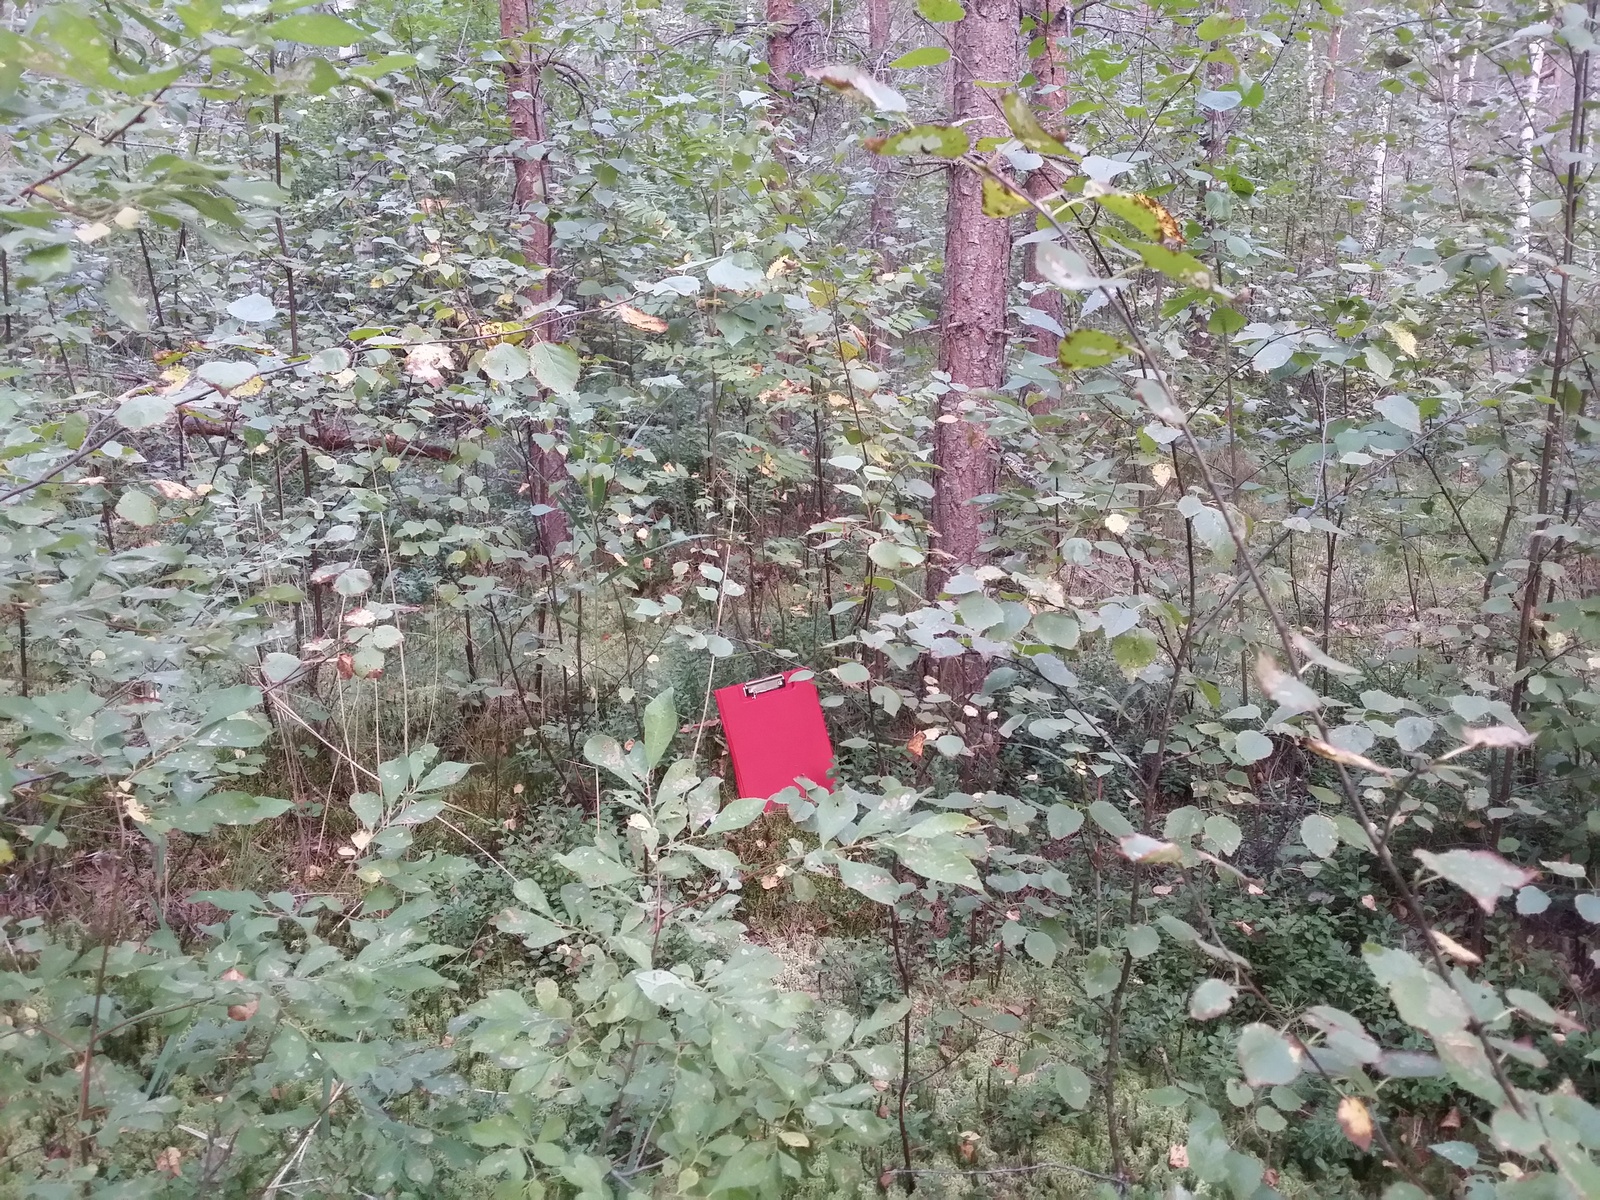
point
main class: Woodland
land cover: Pine dominated mixed woodland
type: hemiboreal forest and nemoral coniferous forest and mixed broadleaved-coniferous forest
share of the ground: > 75 %
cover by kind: coniferous forest trees 35 %, broadleaved forest trees 30 %, herbaceous plants 20 %, shrubs 10 %, lichens and mosses 5 %
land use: Forestry
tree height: > 5 m
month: August
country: LV
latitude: 56.9822
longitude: 27.2317
